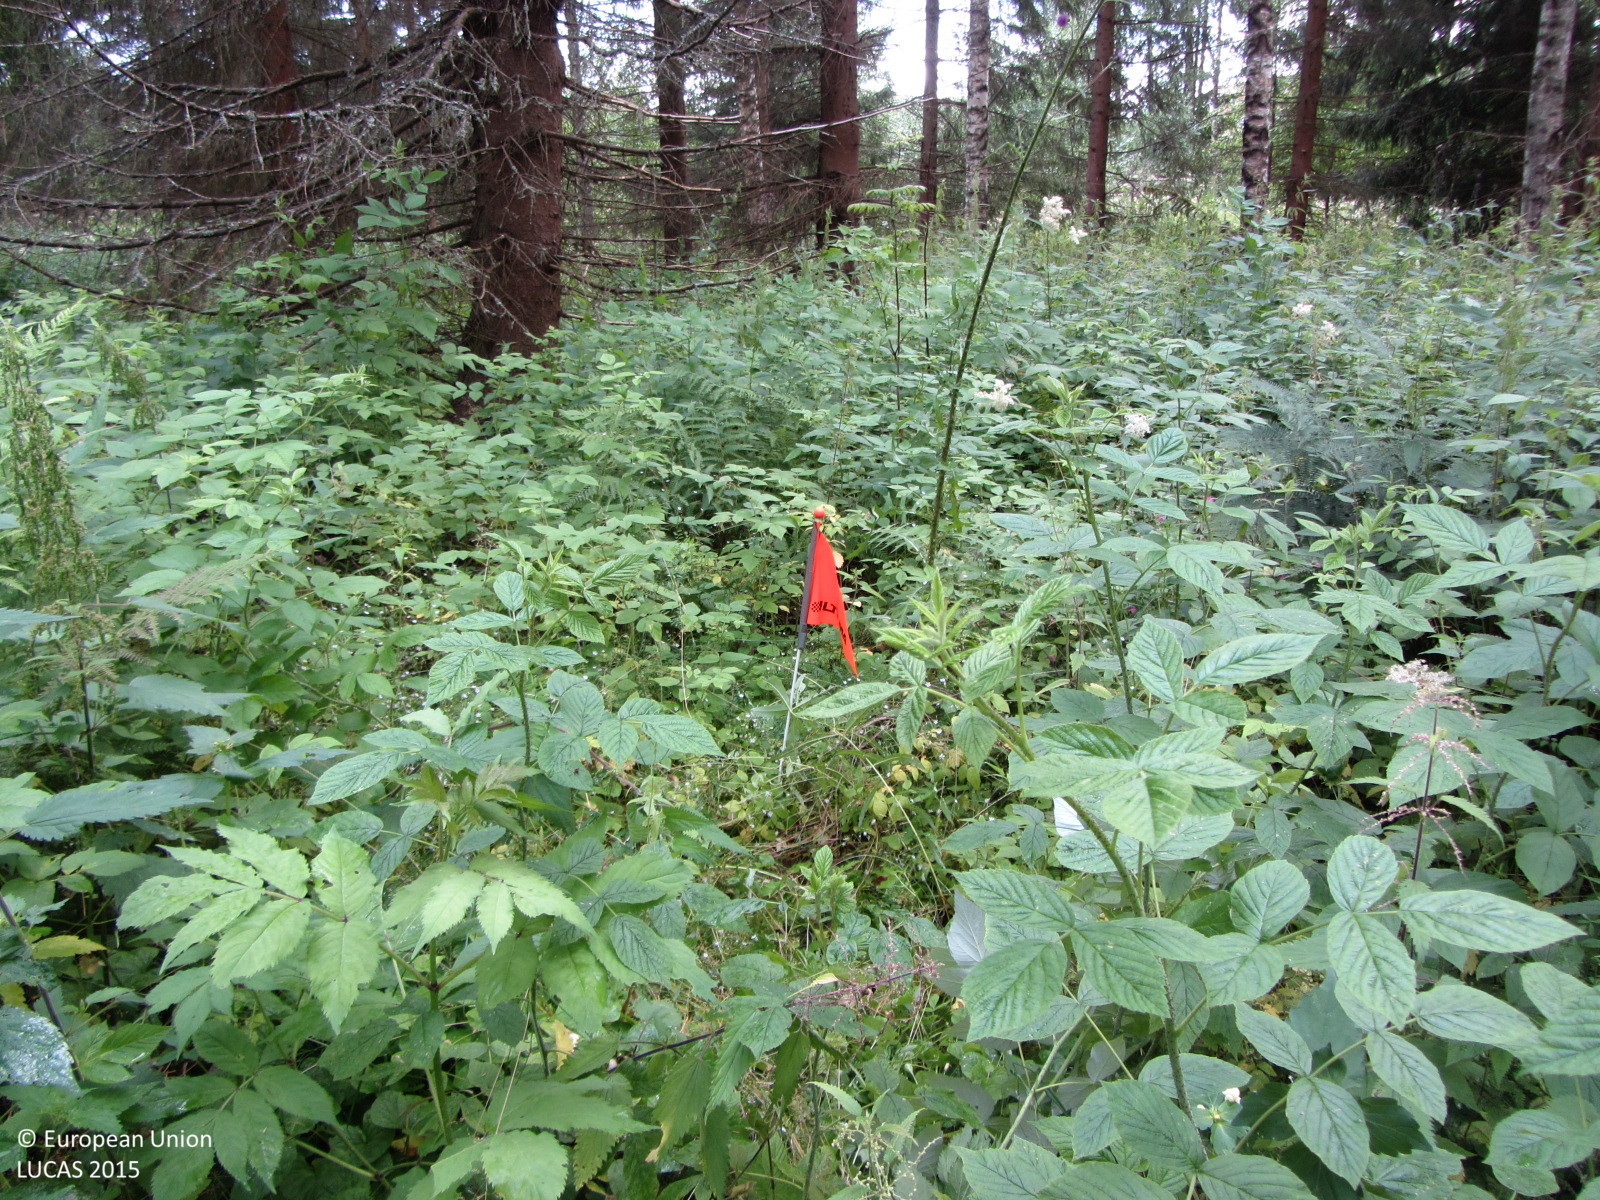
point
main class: Woodland
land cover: Spruce dominated mixed woodland
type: boreal forest
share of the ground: 25 - 50 %
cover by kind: herbaceous plants 55 %, coniferous forest trees 30 %, broadleaved forest trees 15 %
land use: Forestry
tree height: > 5 m
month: July
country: FI
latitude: 60.7033
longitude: 24.7481
